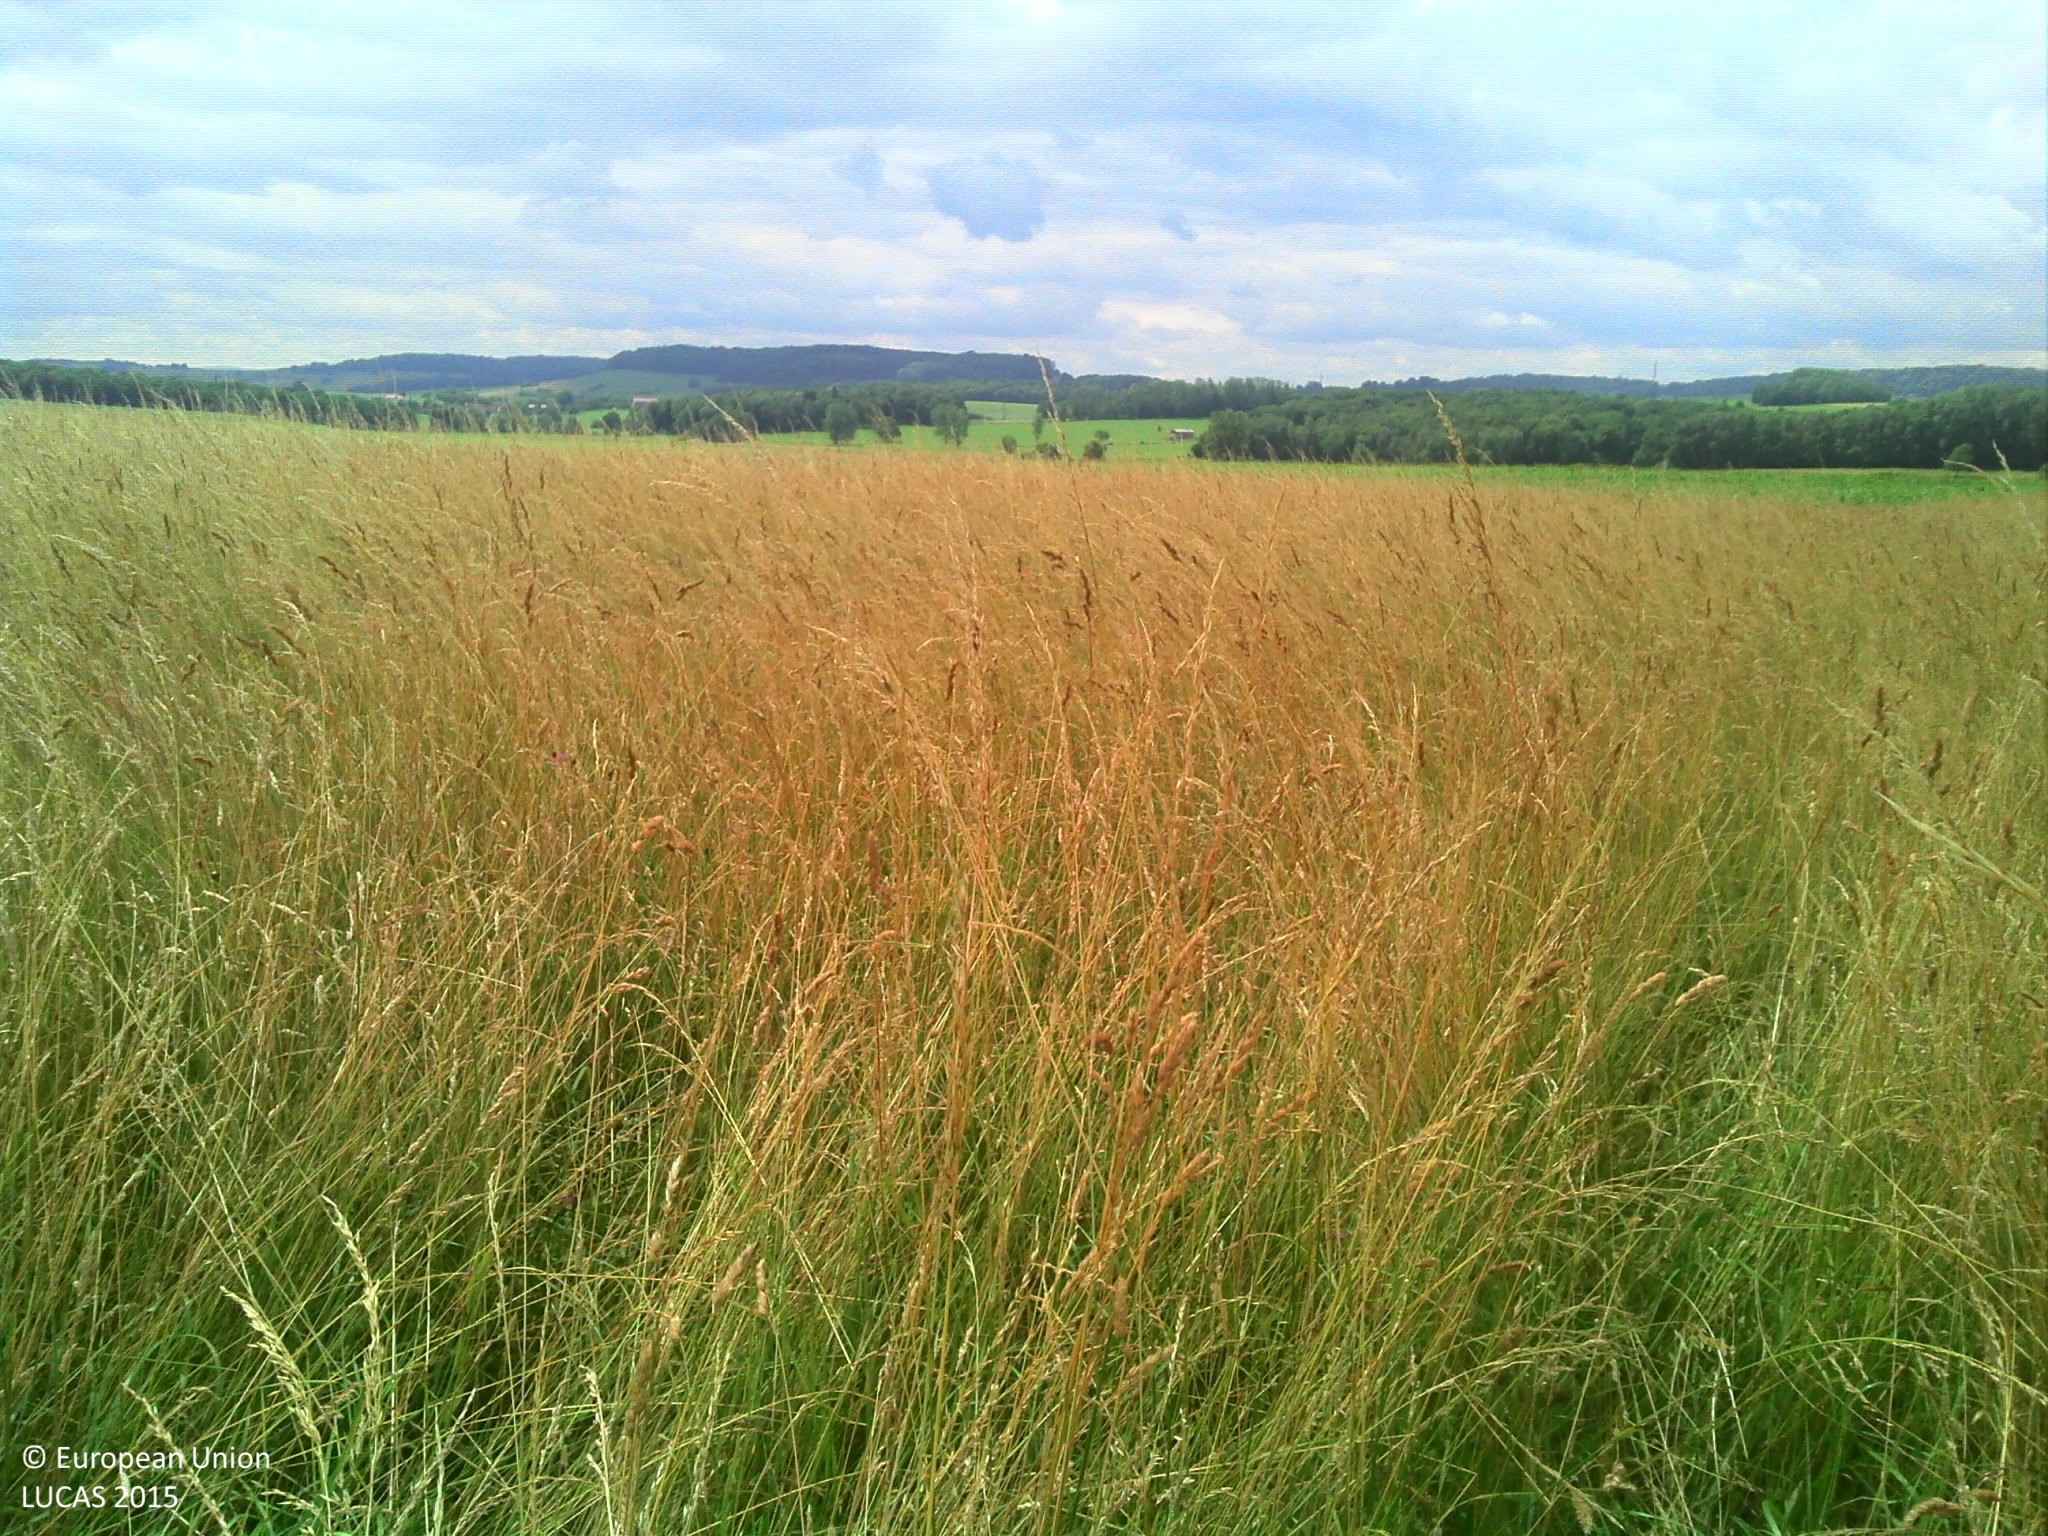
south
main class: Cropland
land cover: Temporary grasslands
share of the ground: > 75 %
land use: Agriculture (excluding fallow land and kitchen gardens)
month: June
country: FR
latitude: 47.6584
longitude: 6.3396
